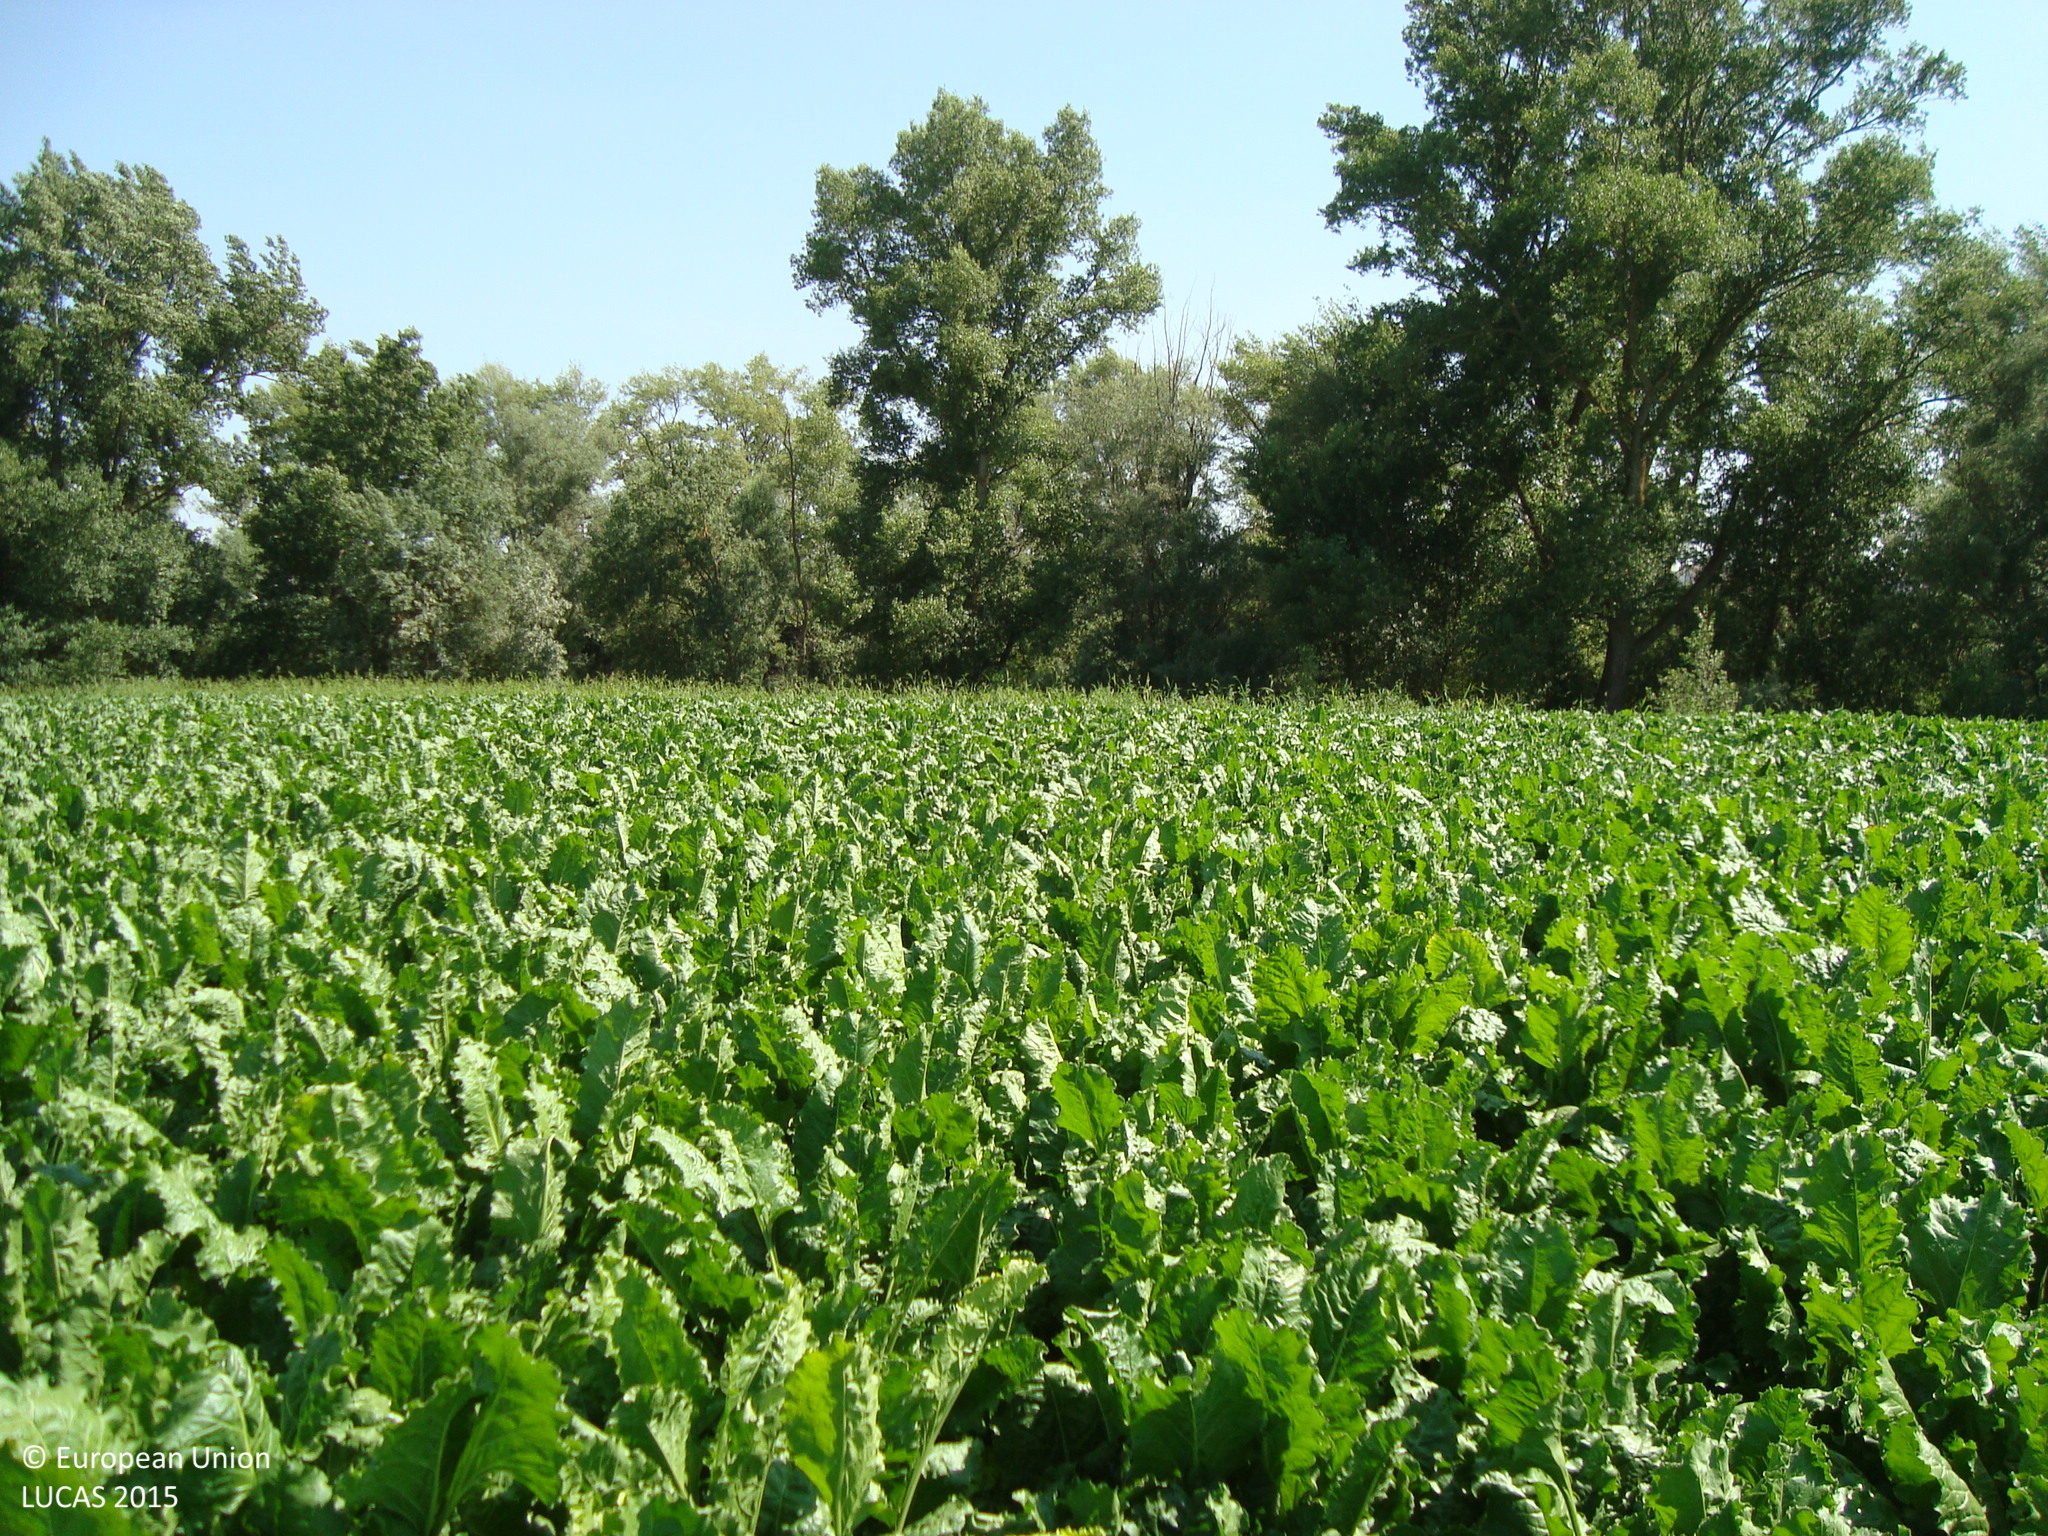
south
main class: Cropland
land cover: Sugar beet
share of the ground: > 75 %
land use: Agriculture (excluding fallow land and kitchen gardens)
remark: Temporary flooded
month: July
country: ES
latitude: 42.0385
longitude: -4.2846
